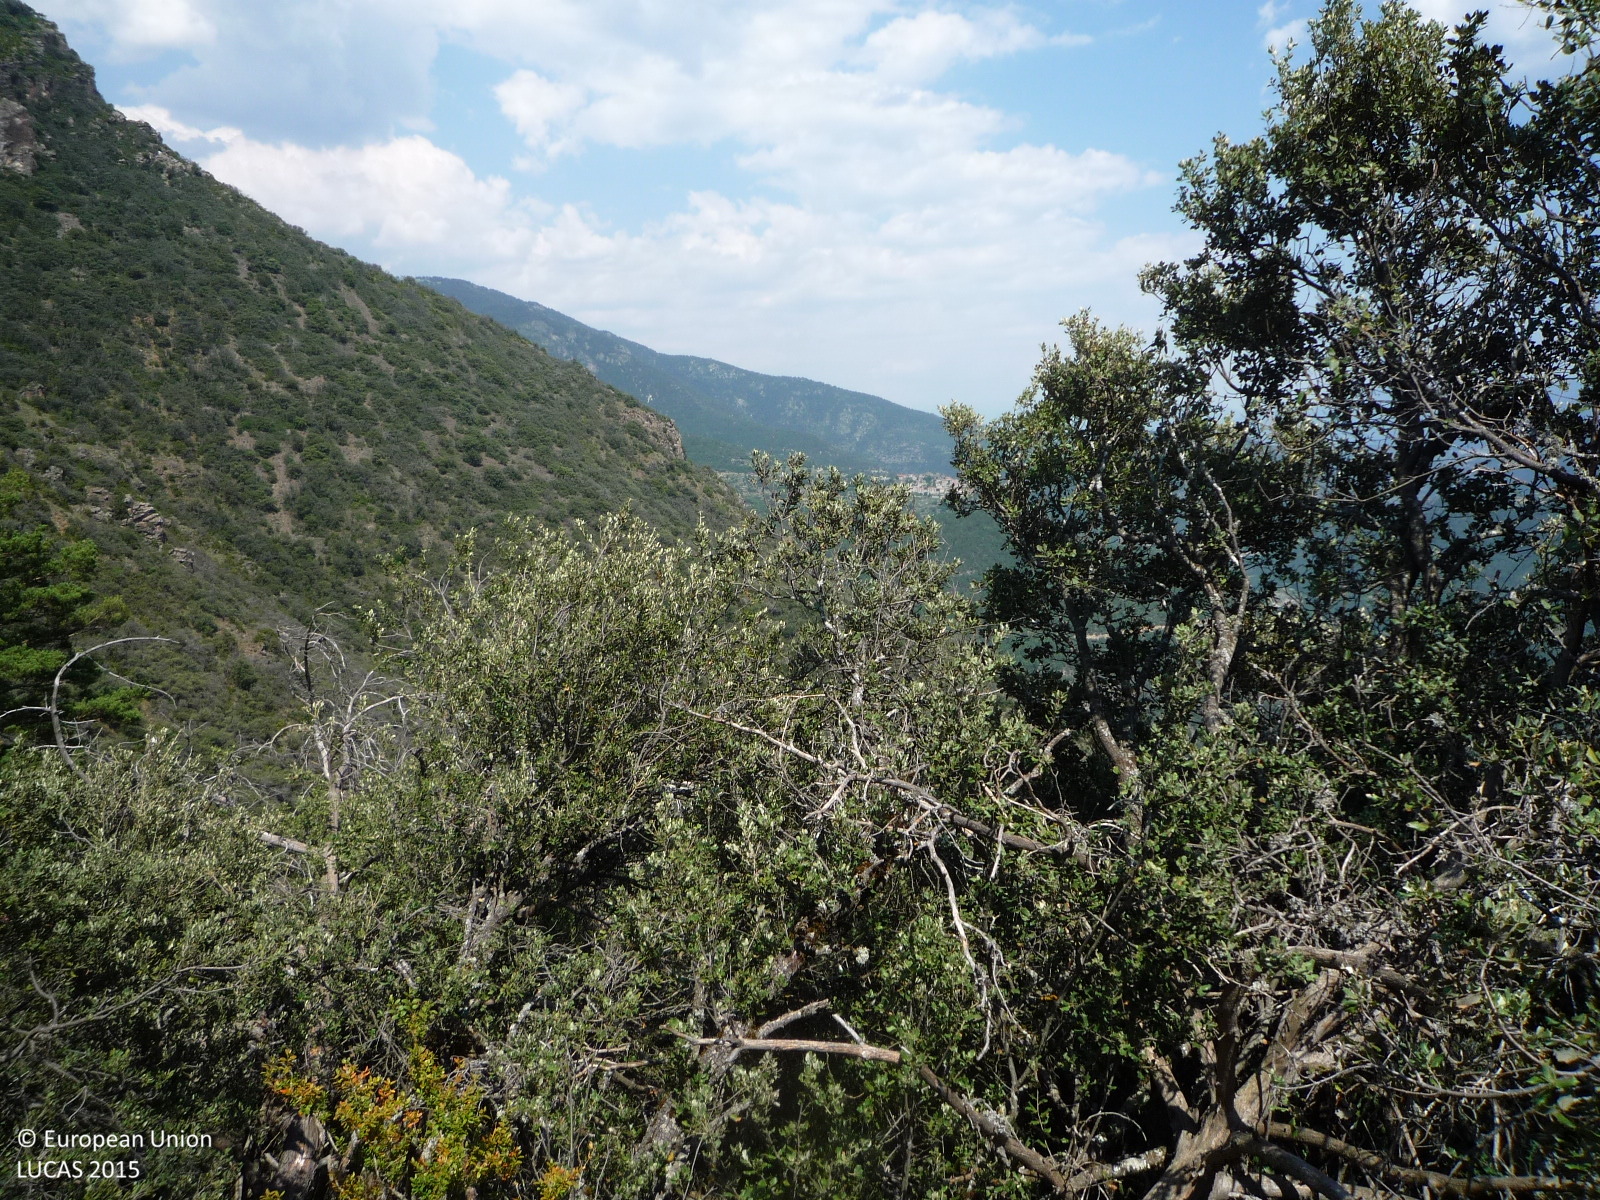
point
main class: Woodland
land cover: Pine dominated mixed woodland
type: alpine coniferous forest
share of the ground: > 75 %
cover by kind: broadleaved forest trees 40 %, coniferous forest trees 30 %, shrubs 20 %, consolidated bare surface 10 %
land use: Semi-natural and natural areas not in use
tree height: < 5 m
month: June
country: ES
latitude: 42.3767
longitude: 1.5941
